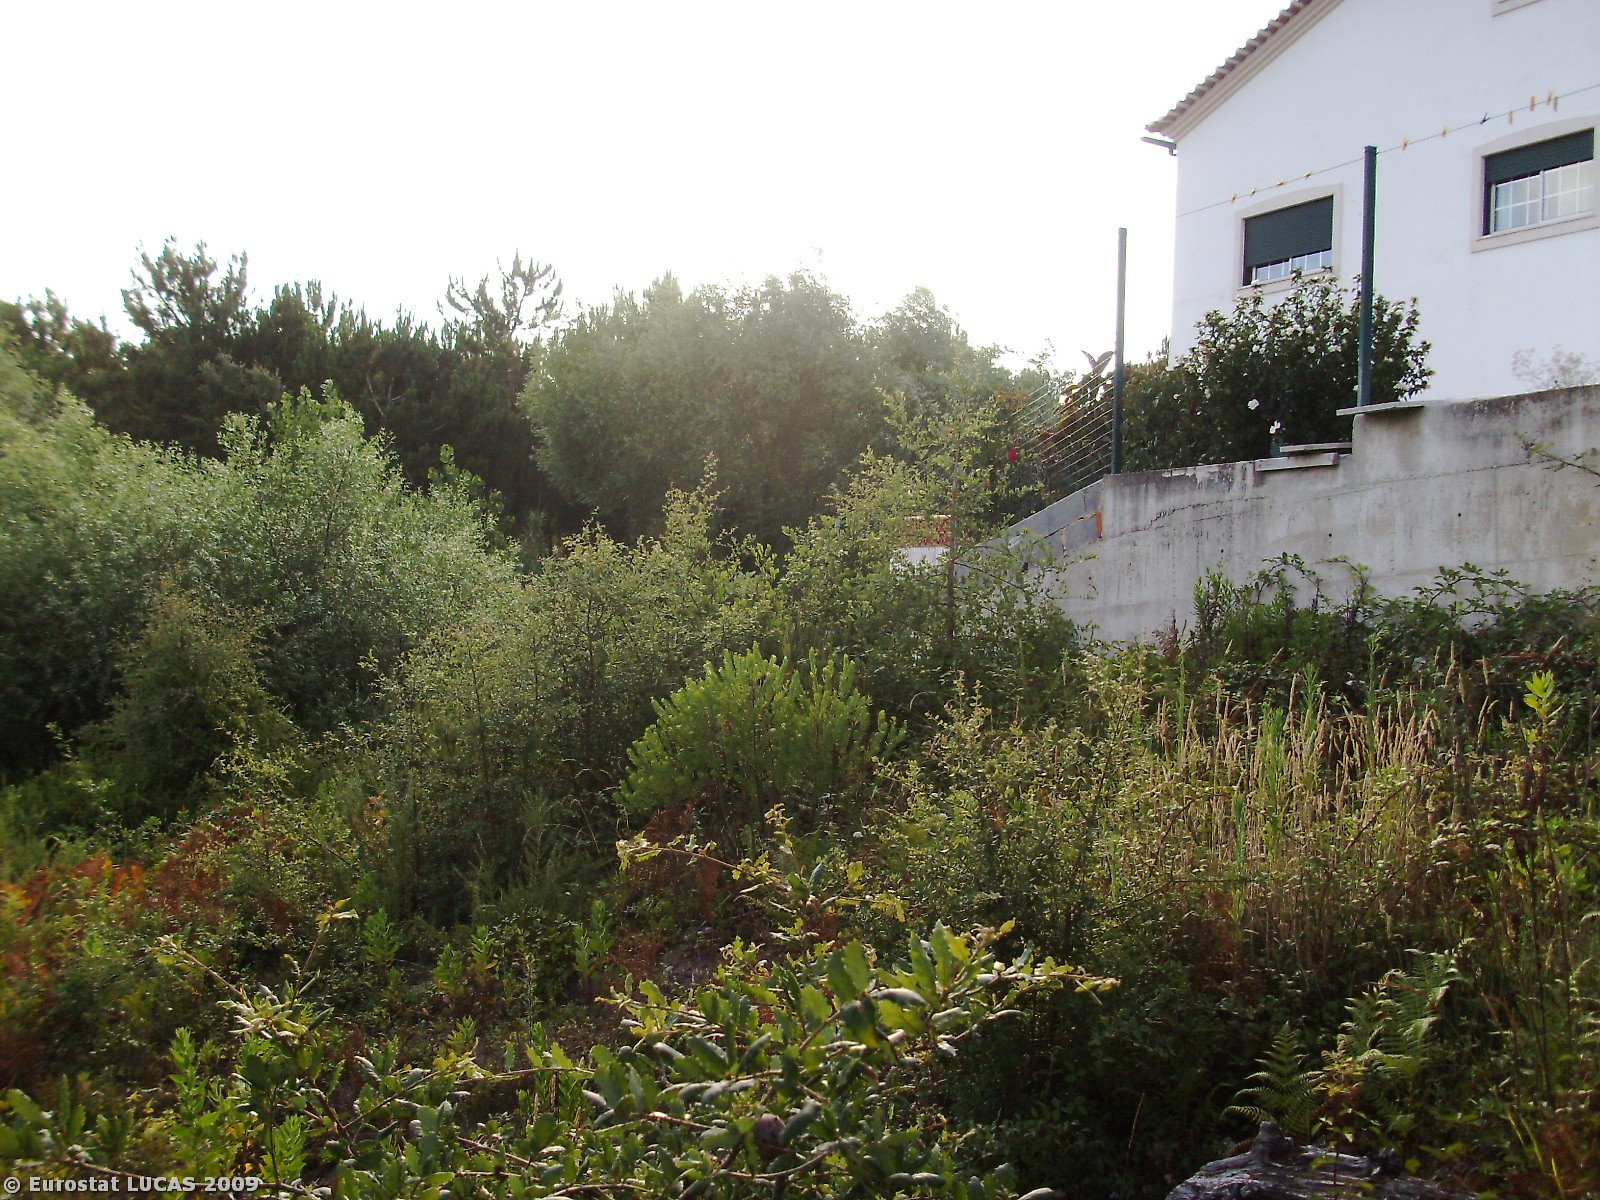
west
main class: Woodland
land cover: Coniferous woodland
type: coniferous forest of the mediterranean region
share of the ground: 10 - 25 %
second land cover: Shrubland with sparse tree cover
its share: 50 - 75 %
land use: Forestry
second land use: Fallow land
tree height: > 5 m
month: July
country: PT
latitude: 39.6720
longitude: -8.9869
